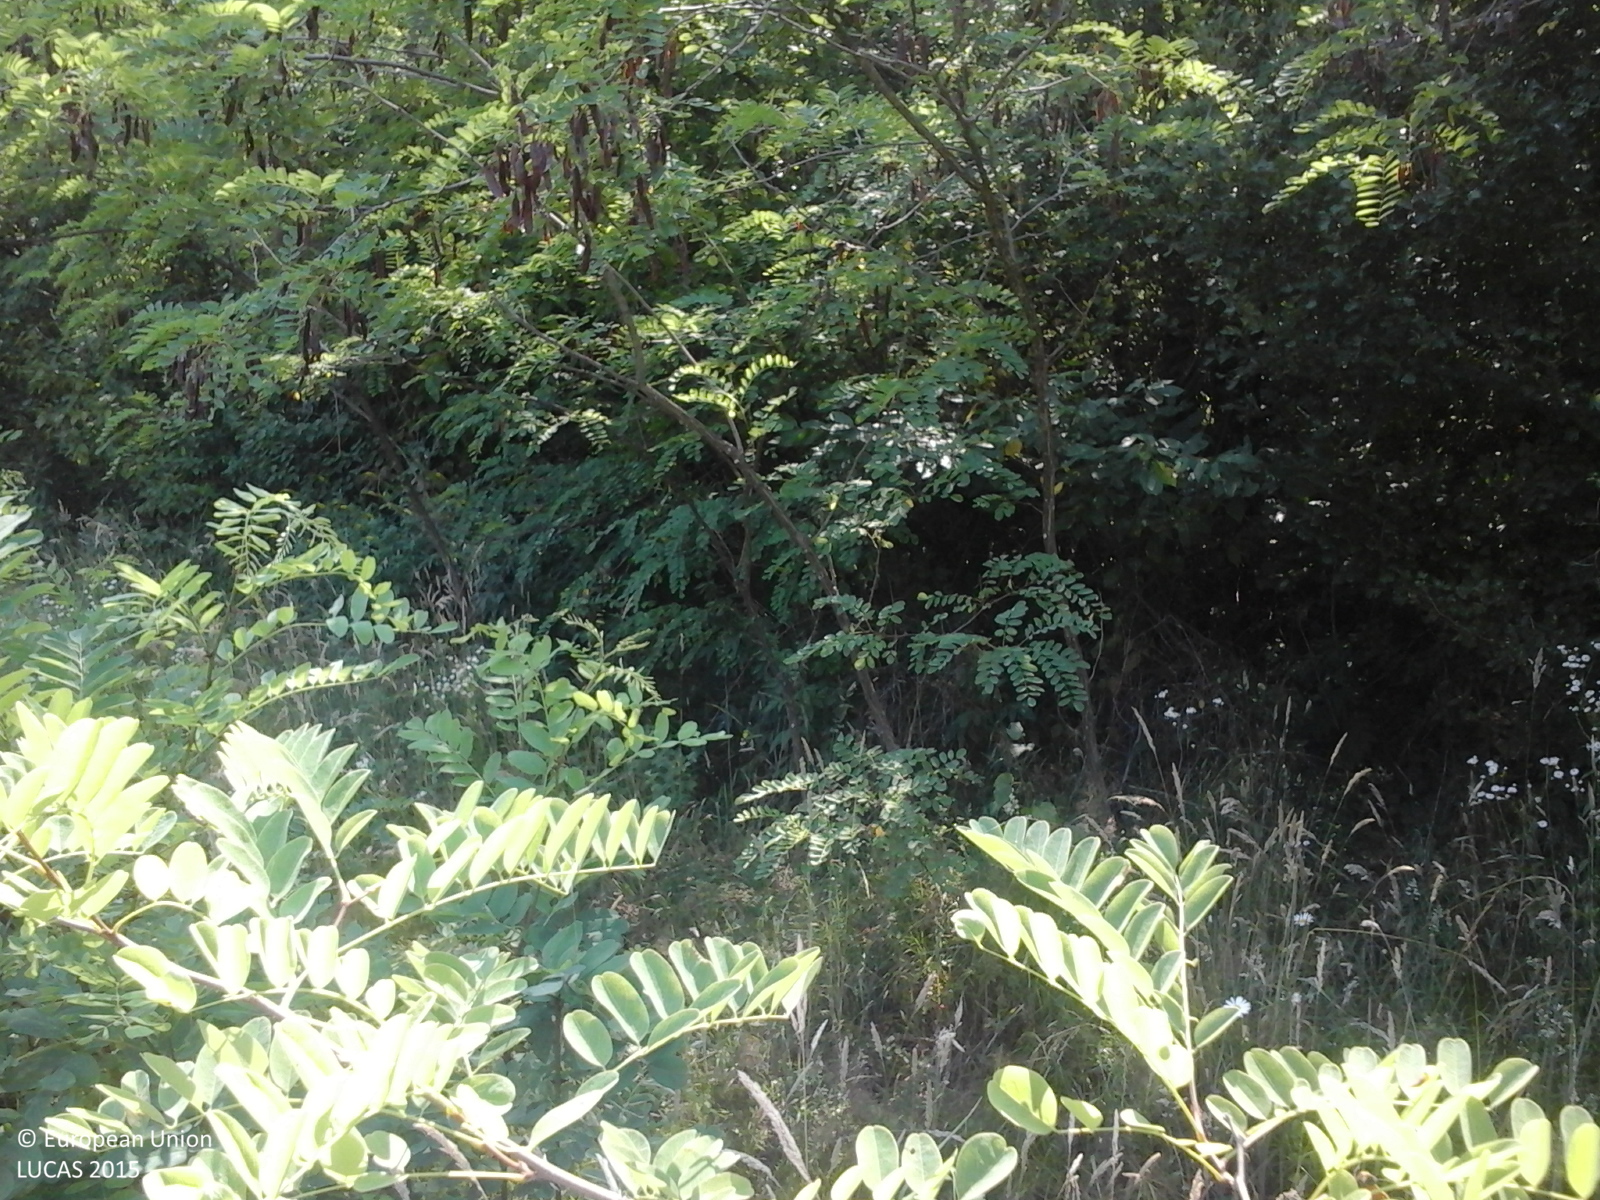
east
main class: Woodland
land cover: Broadleaved woodland
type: thermophilous deciduous forest
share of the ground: > 75 %
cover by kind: broadleaved forest trees 100 %
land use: Forestry
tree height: > 5 m
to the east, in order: Broadleaved woodland; Tracks; Broadleaved woodland
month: July
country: RO
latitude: 44.8397
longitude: 24.5344
